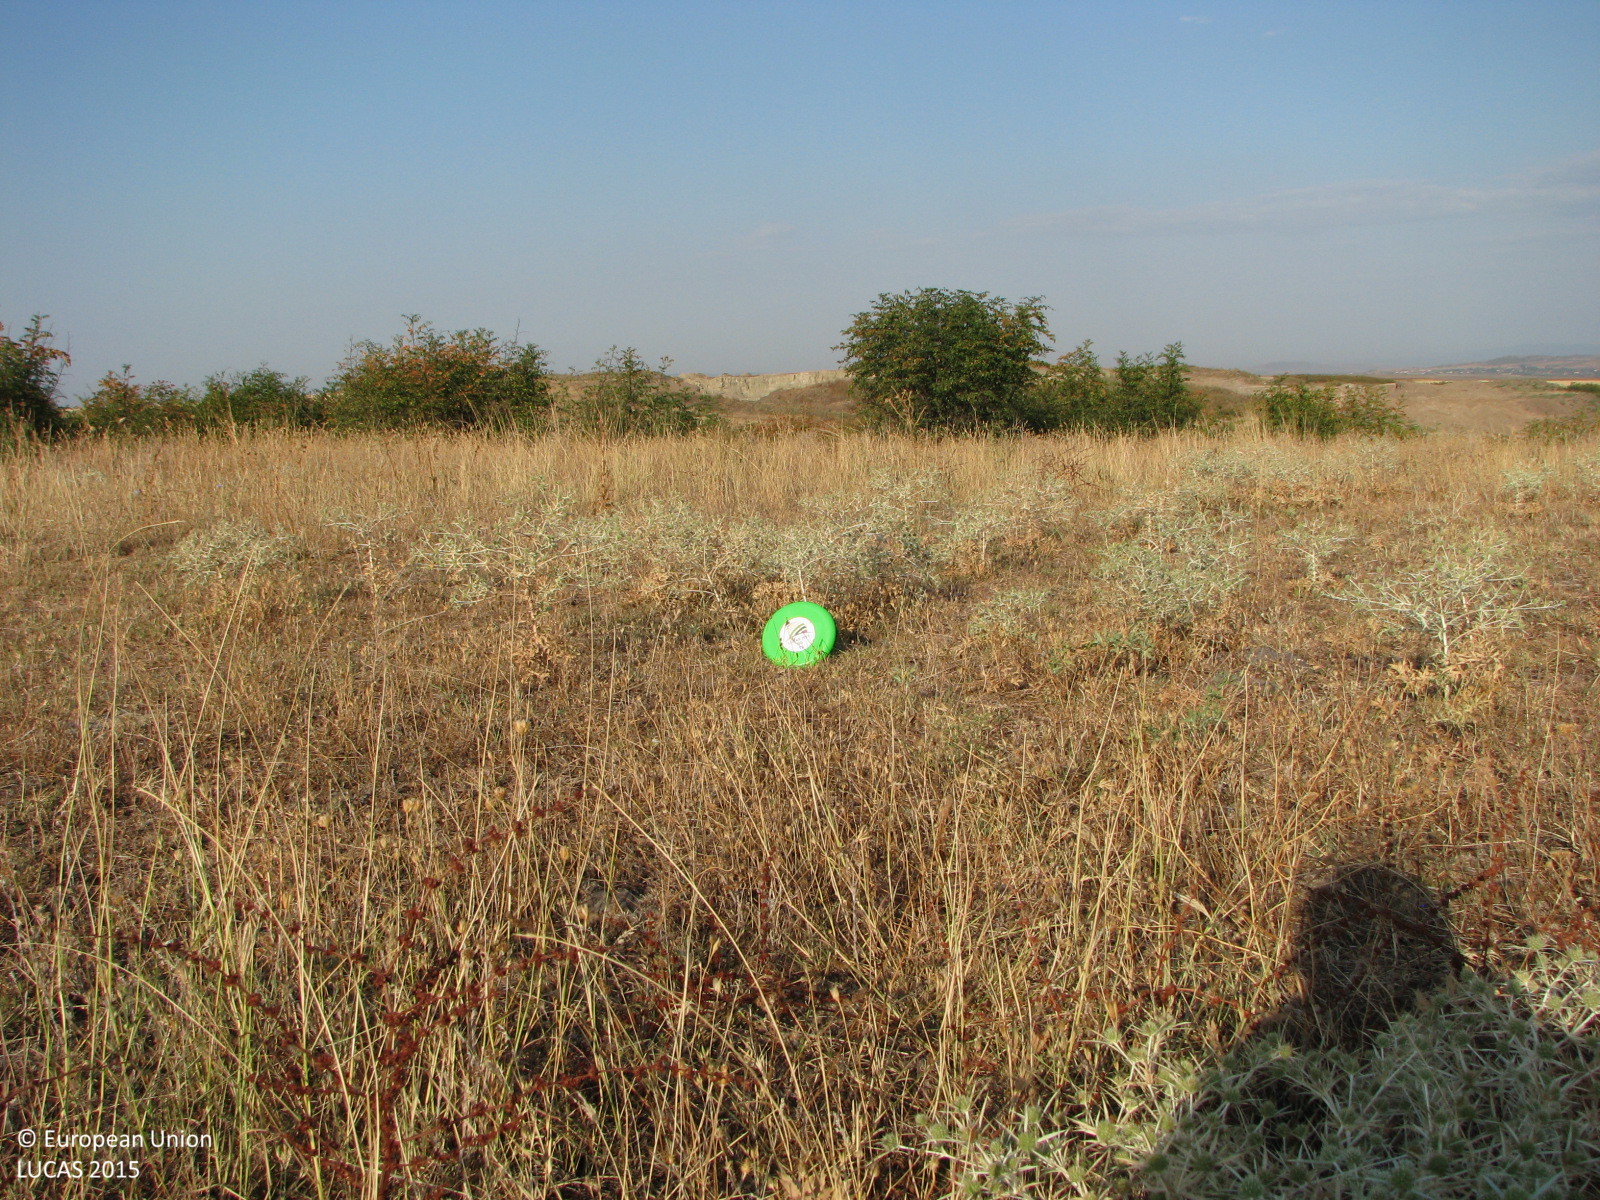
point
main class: Grassland
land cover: Grassland with sparse tree/shrub cover
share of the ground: > 75 %
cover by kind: herbaceous plants 90 %, broadleaved forest trees 5 %, shrubs 5 %
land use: Agriculture (excluding fallow land and kitchen gardens)
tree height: < 5 m
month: August
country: BG
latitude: 42.5142
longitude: 26.4370
